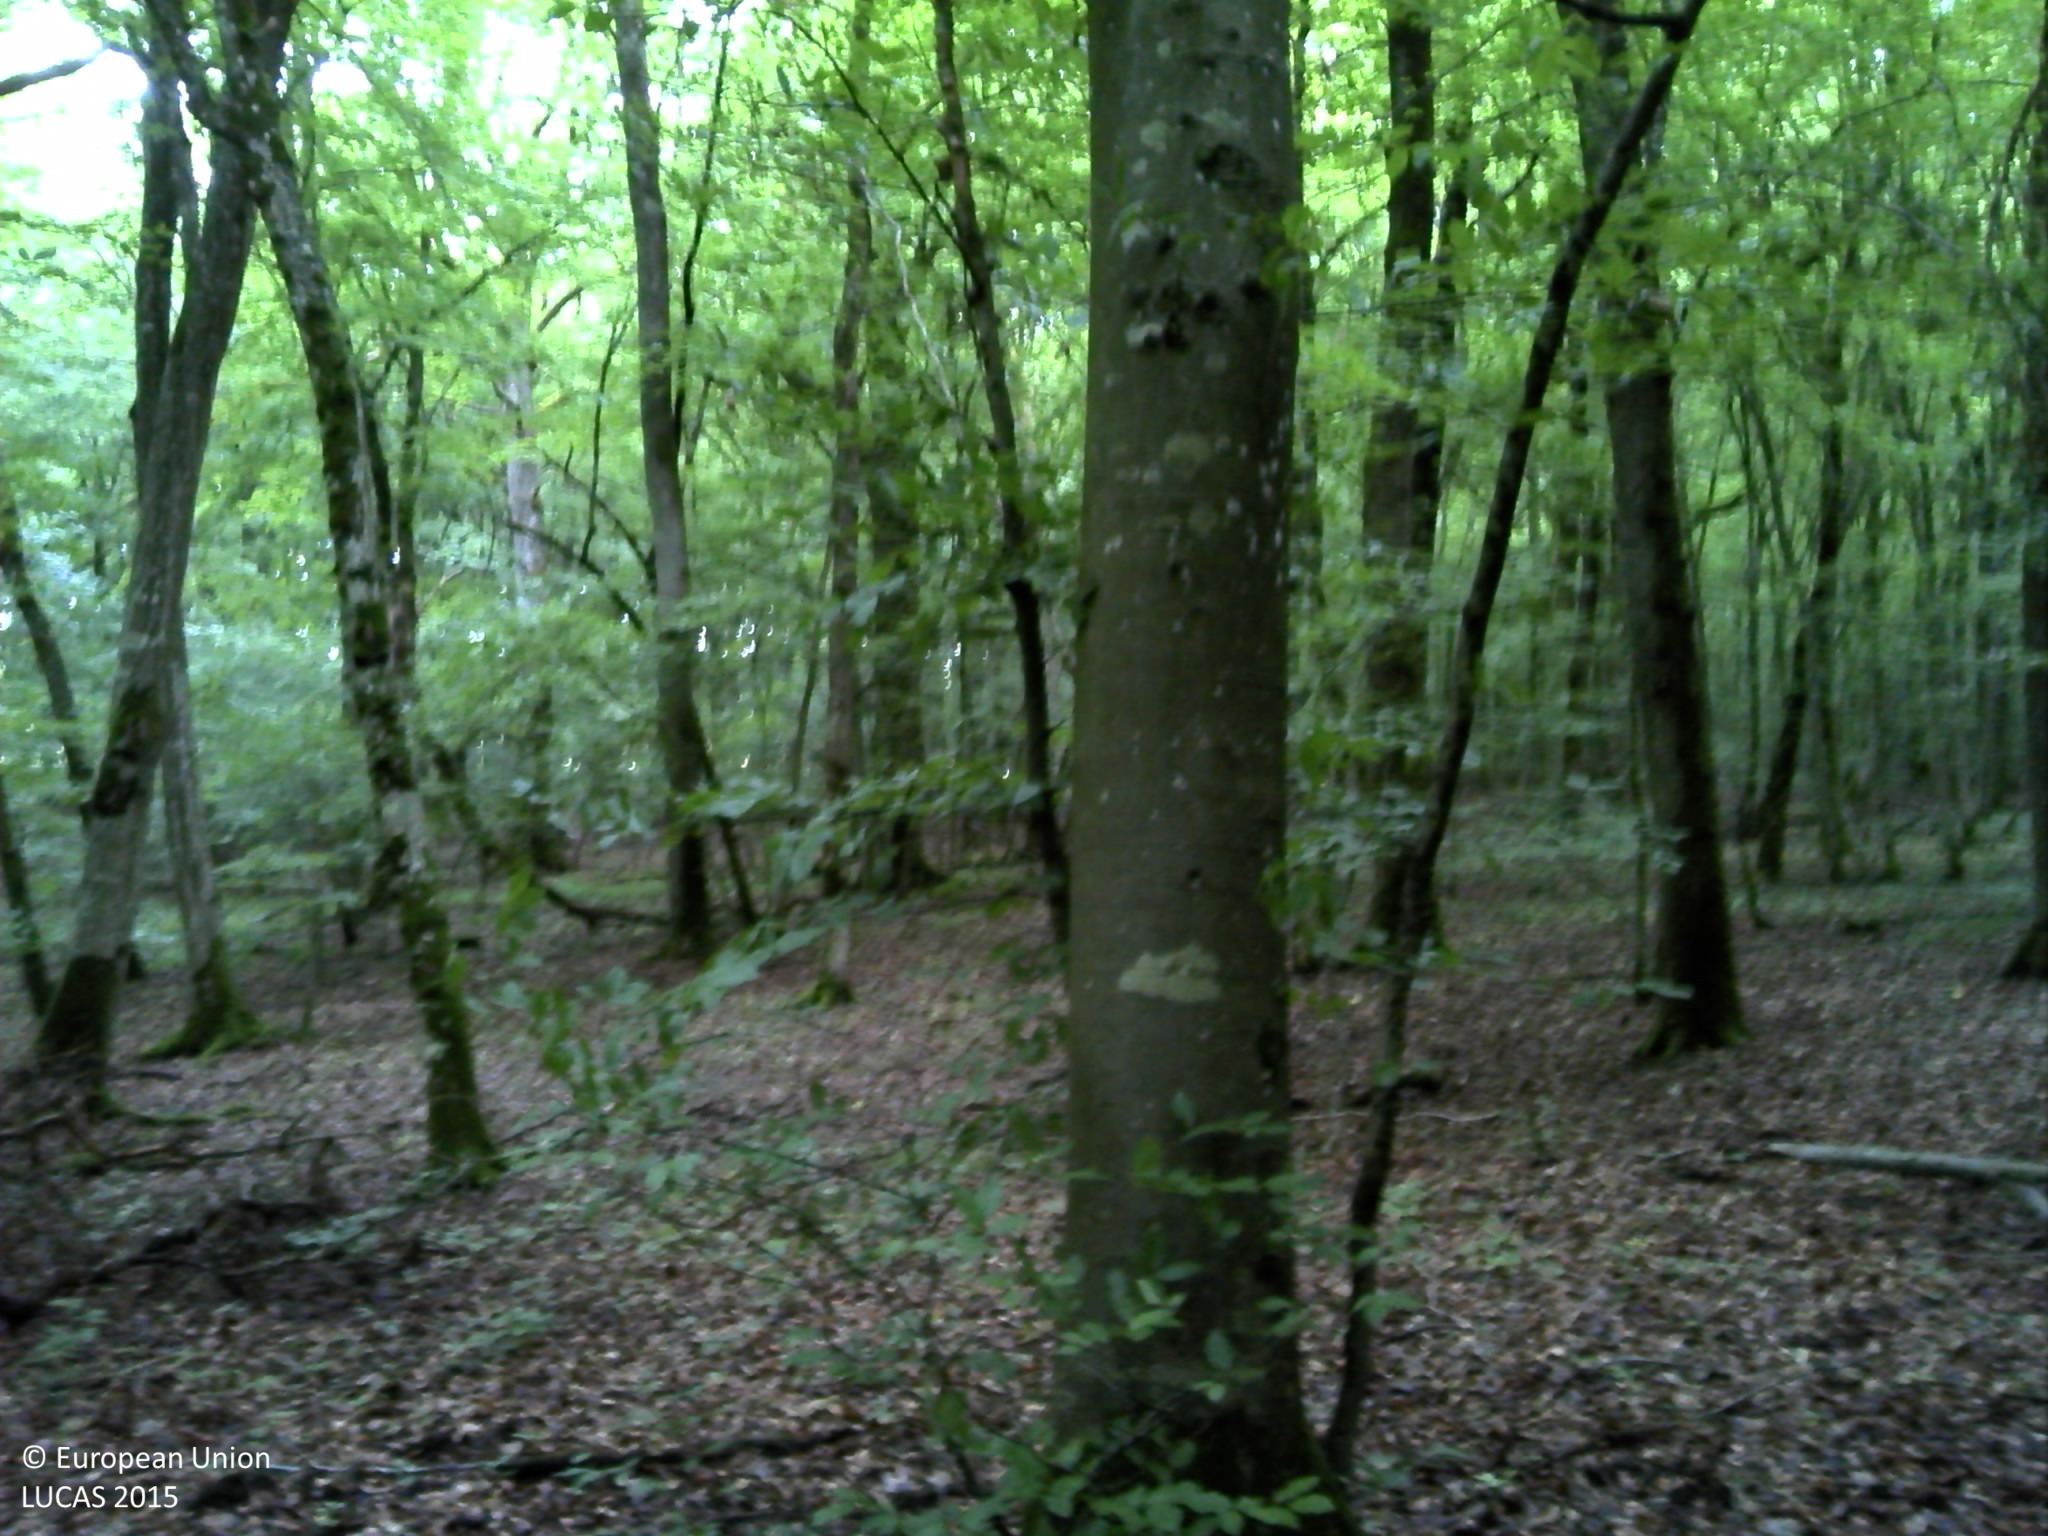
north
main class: Woodland
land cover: Broadleaved woodland
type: acidophilous oak and oak-birch forest
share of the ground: > 75 %
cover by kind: broadleaved forest trees 100 %
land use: Forestry
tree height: > 5 m
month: June
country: FR
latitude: 49.0131
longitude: 6.4589
